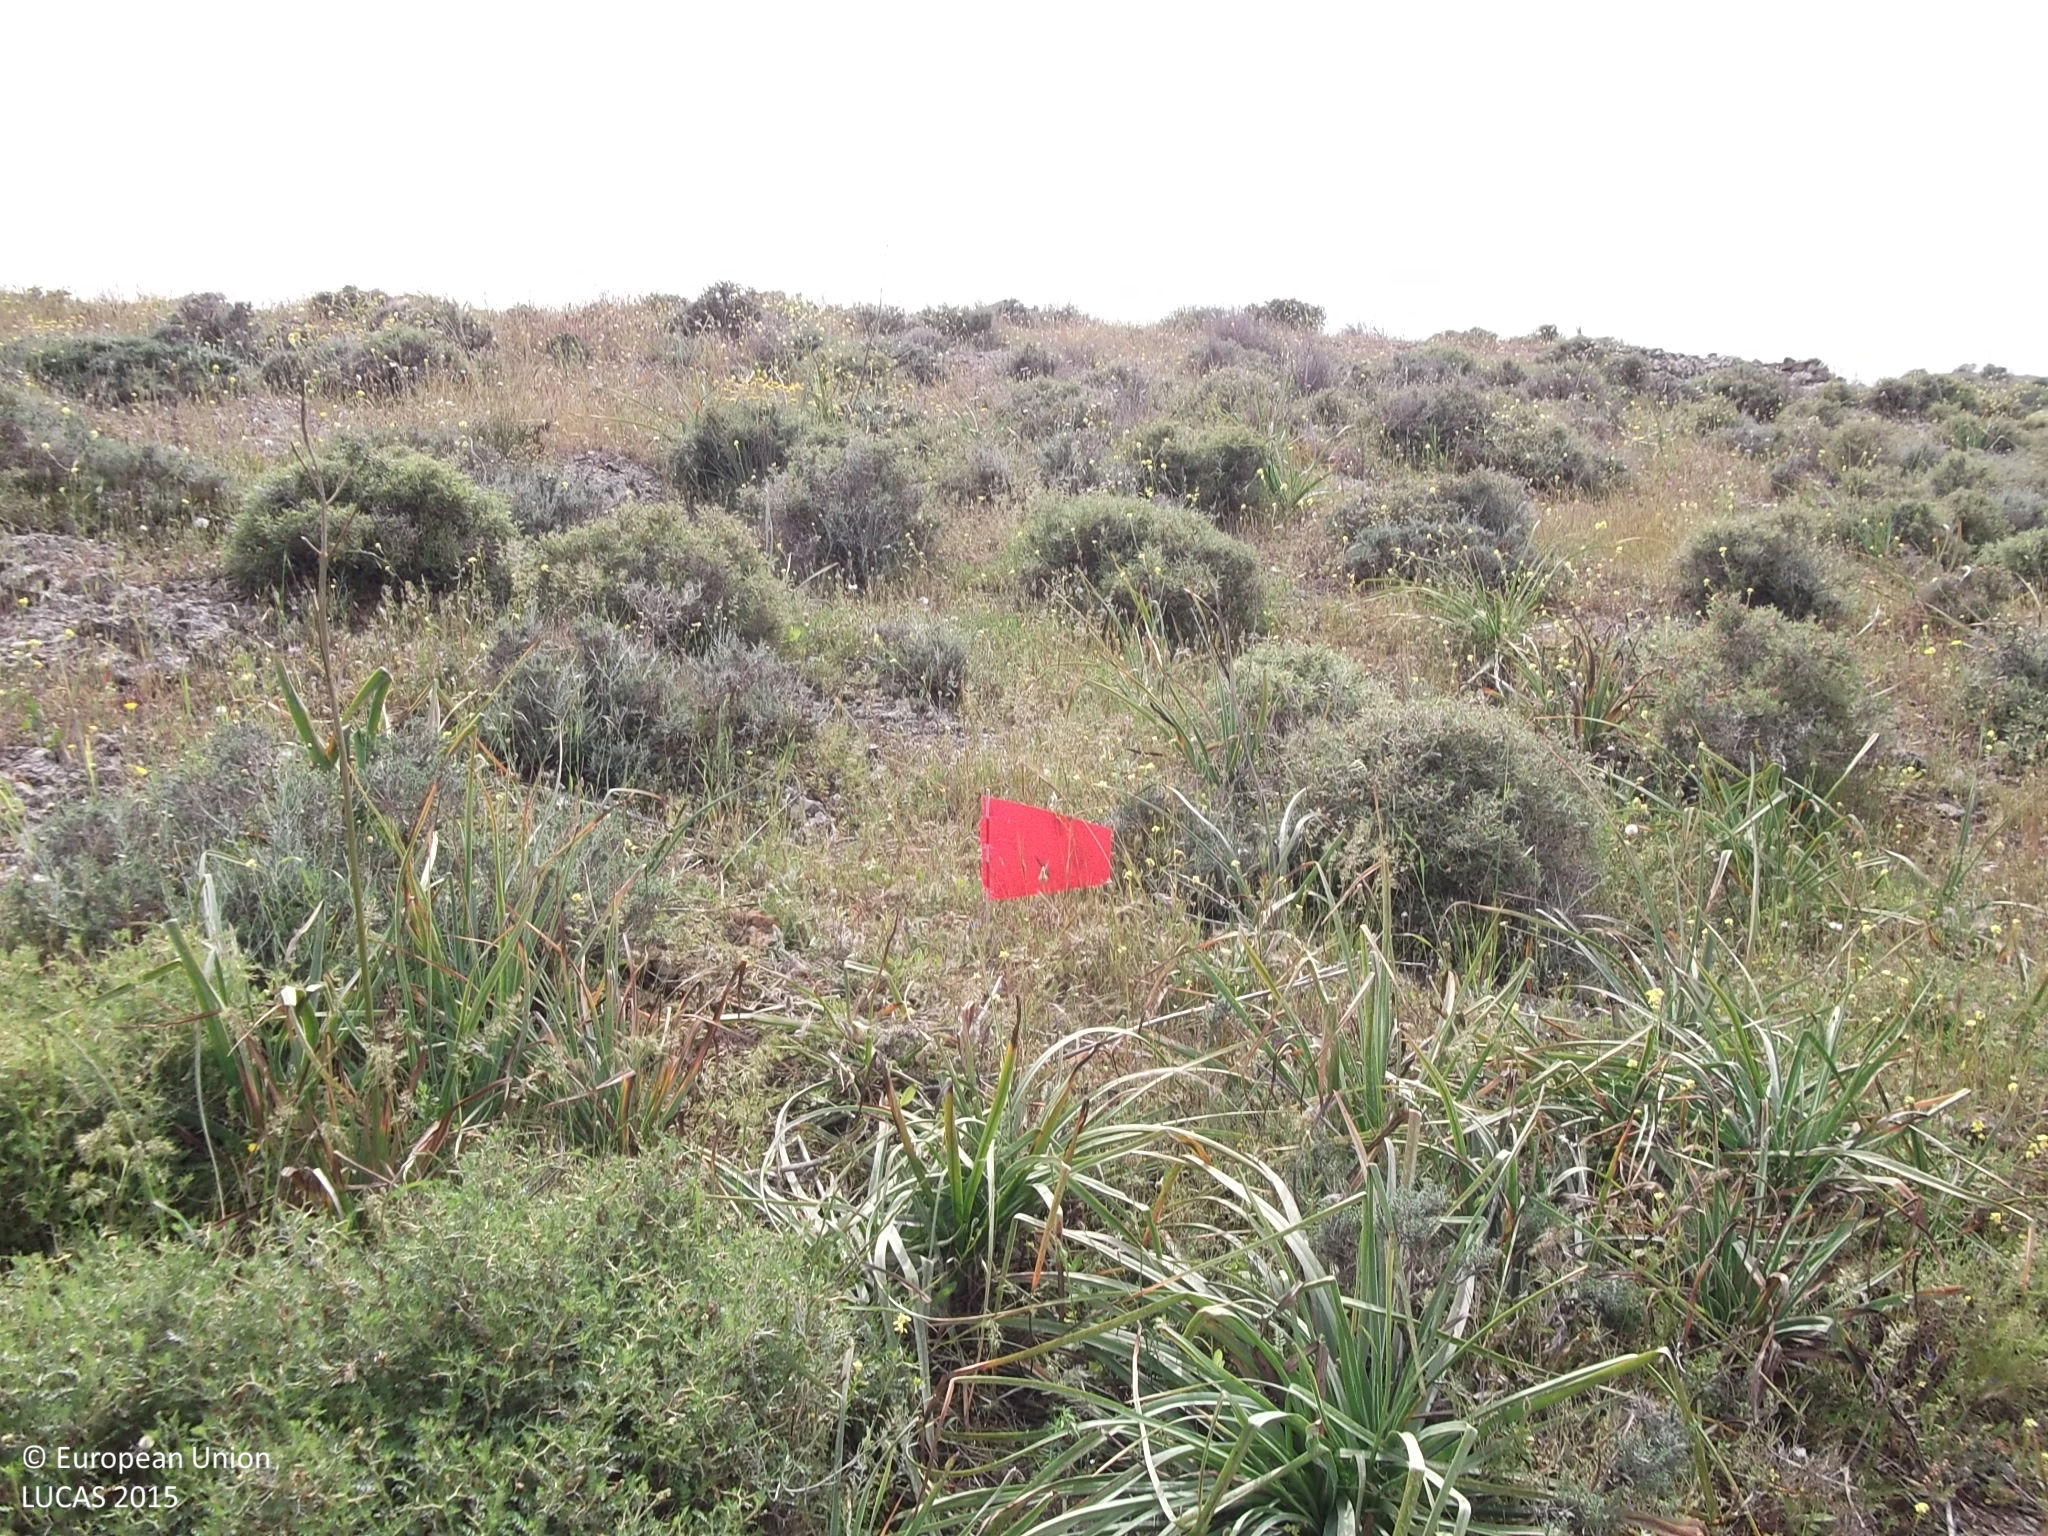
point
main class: Shrubland
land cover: Shrubland without tree cover
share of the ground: > 75 %
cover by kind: shrubs 70 %, herbaceous plants 20 %, unconsolidated bare surface 10 %
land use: Semi-natural and natural areas not in use
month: April
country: CY
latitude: 35.0096
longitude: 33.6164
